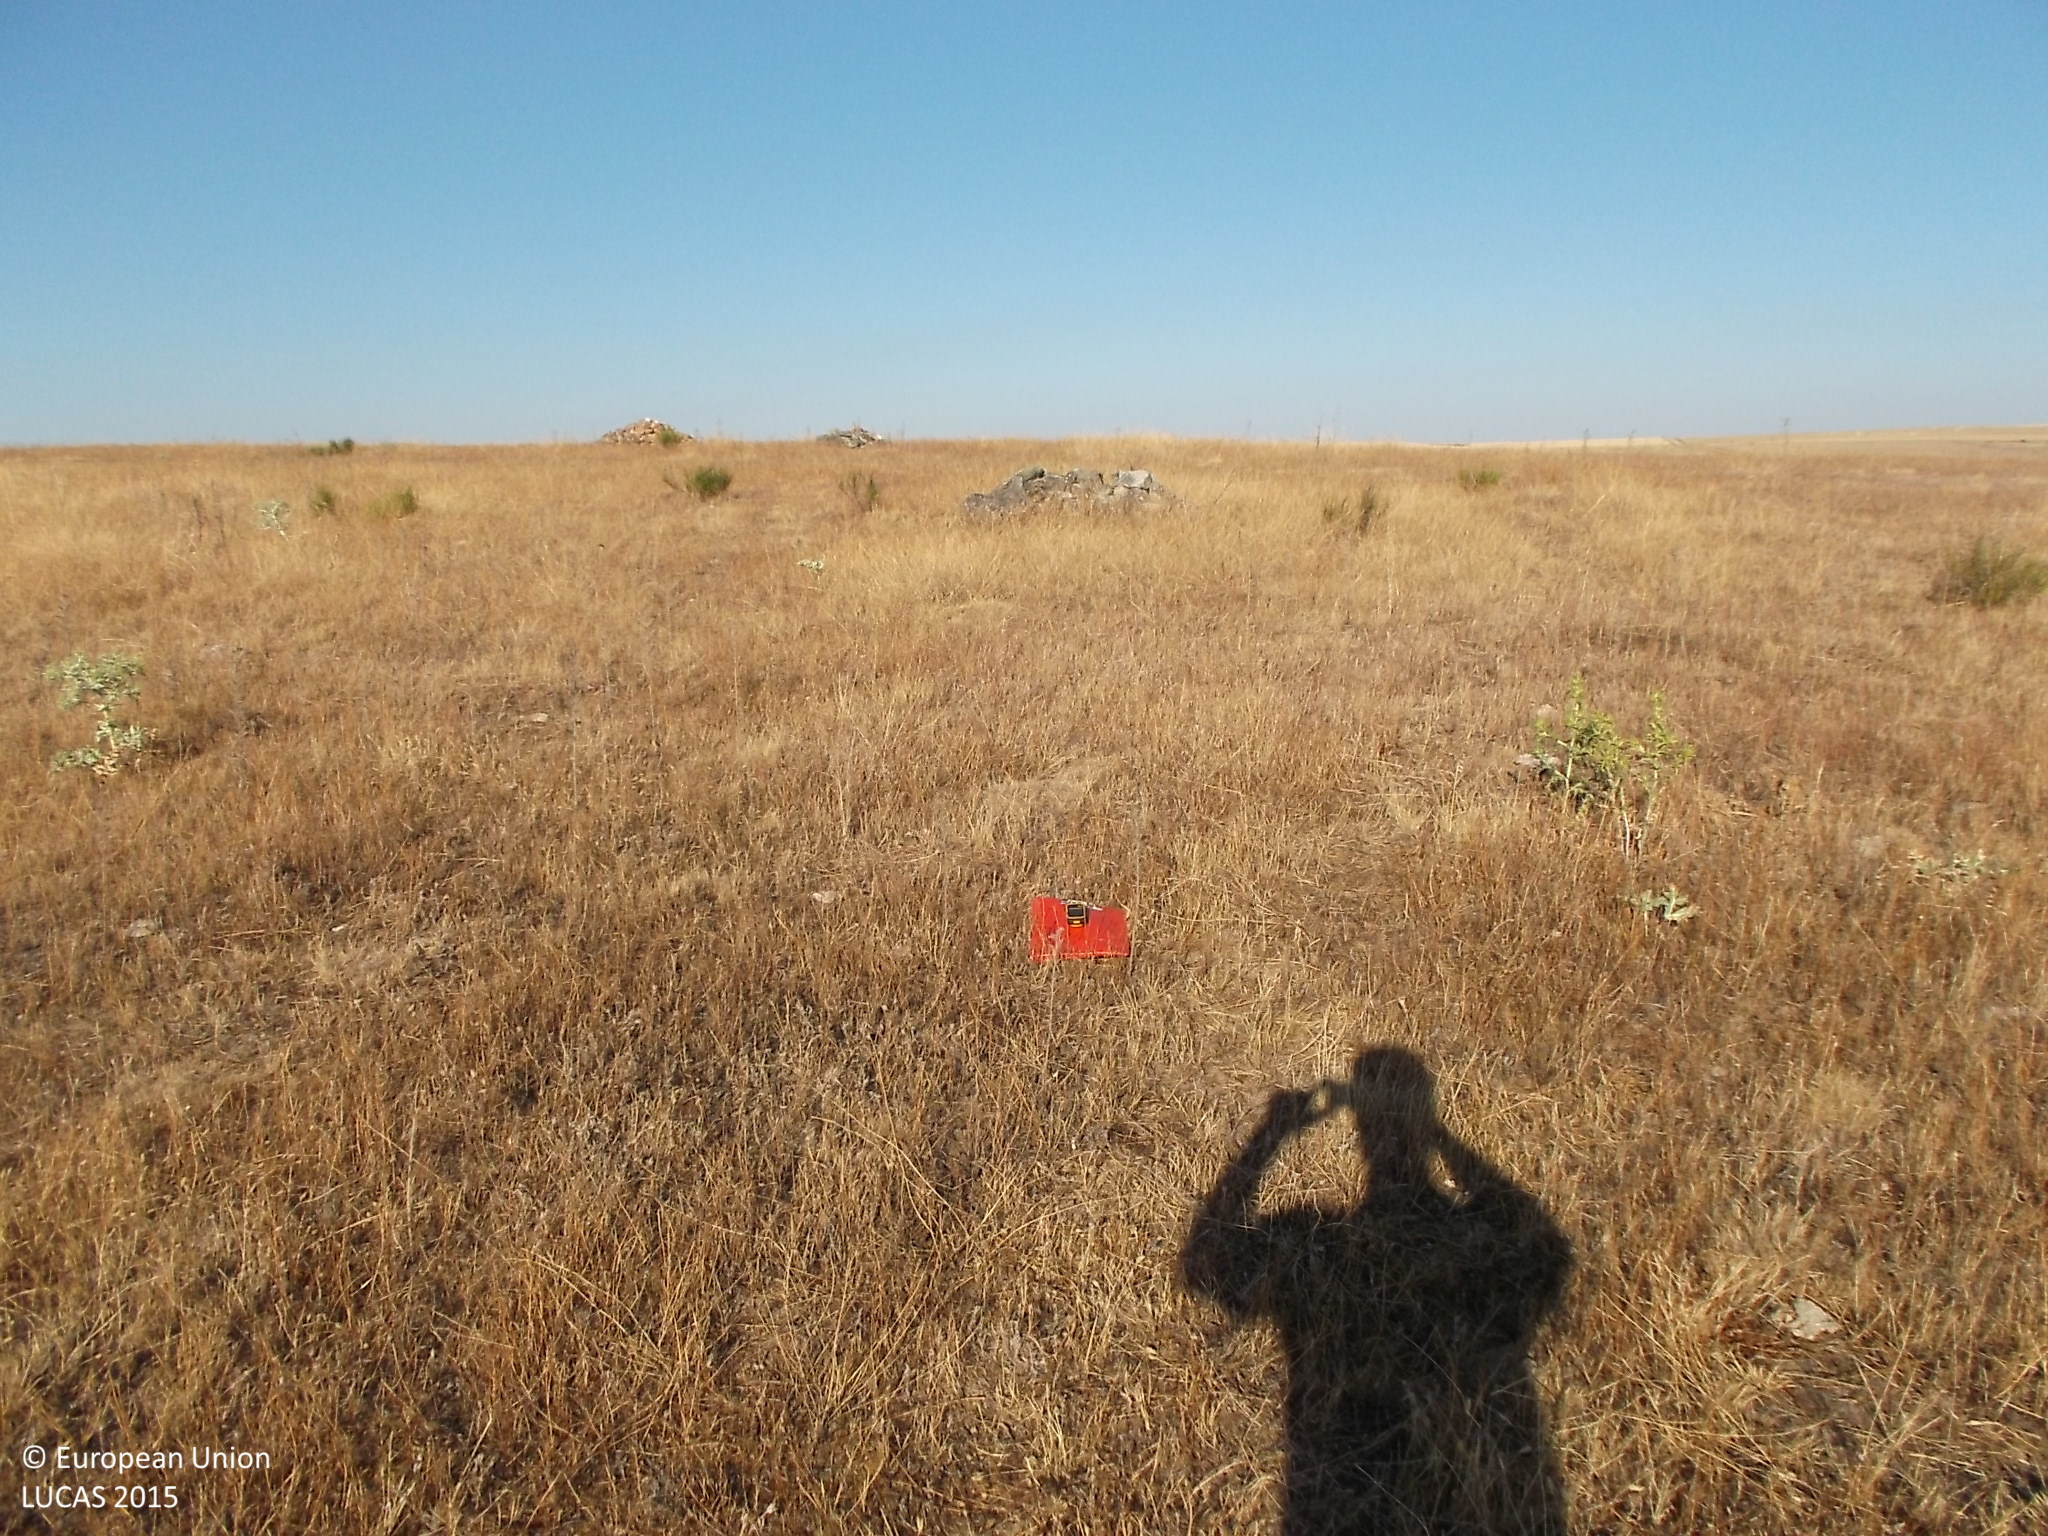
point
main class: Grassland
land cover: Grassland without tree/shrub cover
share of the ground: > 75 %
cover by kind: herbaceous plants 100 %
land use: Agriculture (excluding fallow land and kitchen gardens)
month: July
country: ES
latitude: 41.1428
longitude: -5.9433
